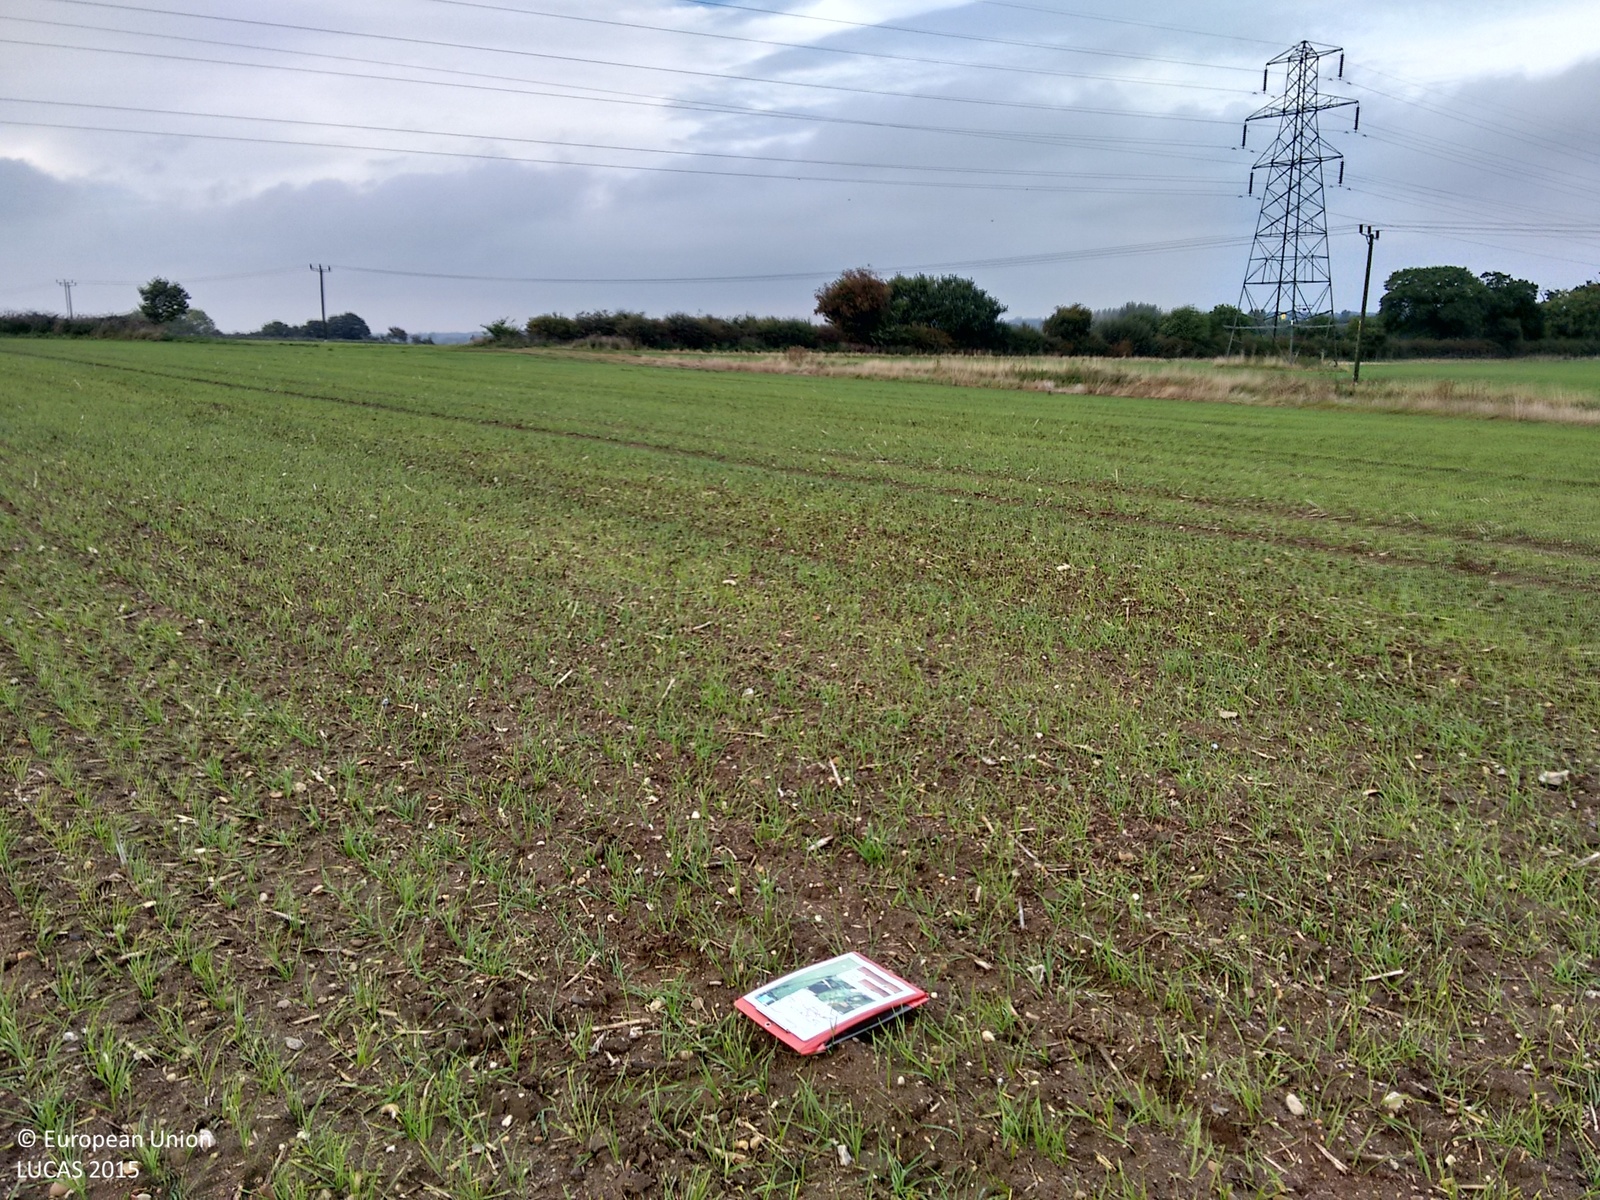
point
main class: Cropland
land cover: Common wheat
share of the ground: 10 - 25 %
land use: Agriculture (excluding fallow land and kitchen gardens)
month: October
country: GB
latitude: 52.4533
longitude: 1.5198
